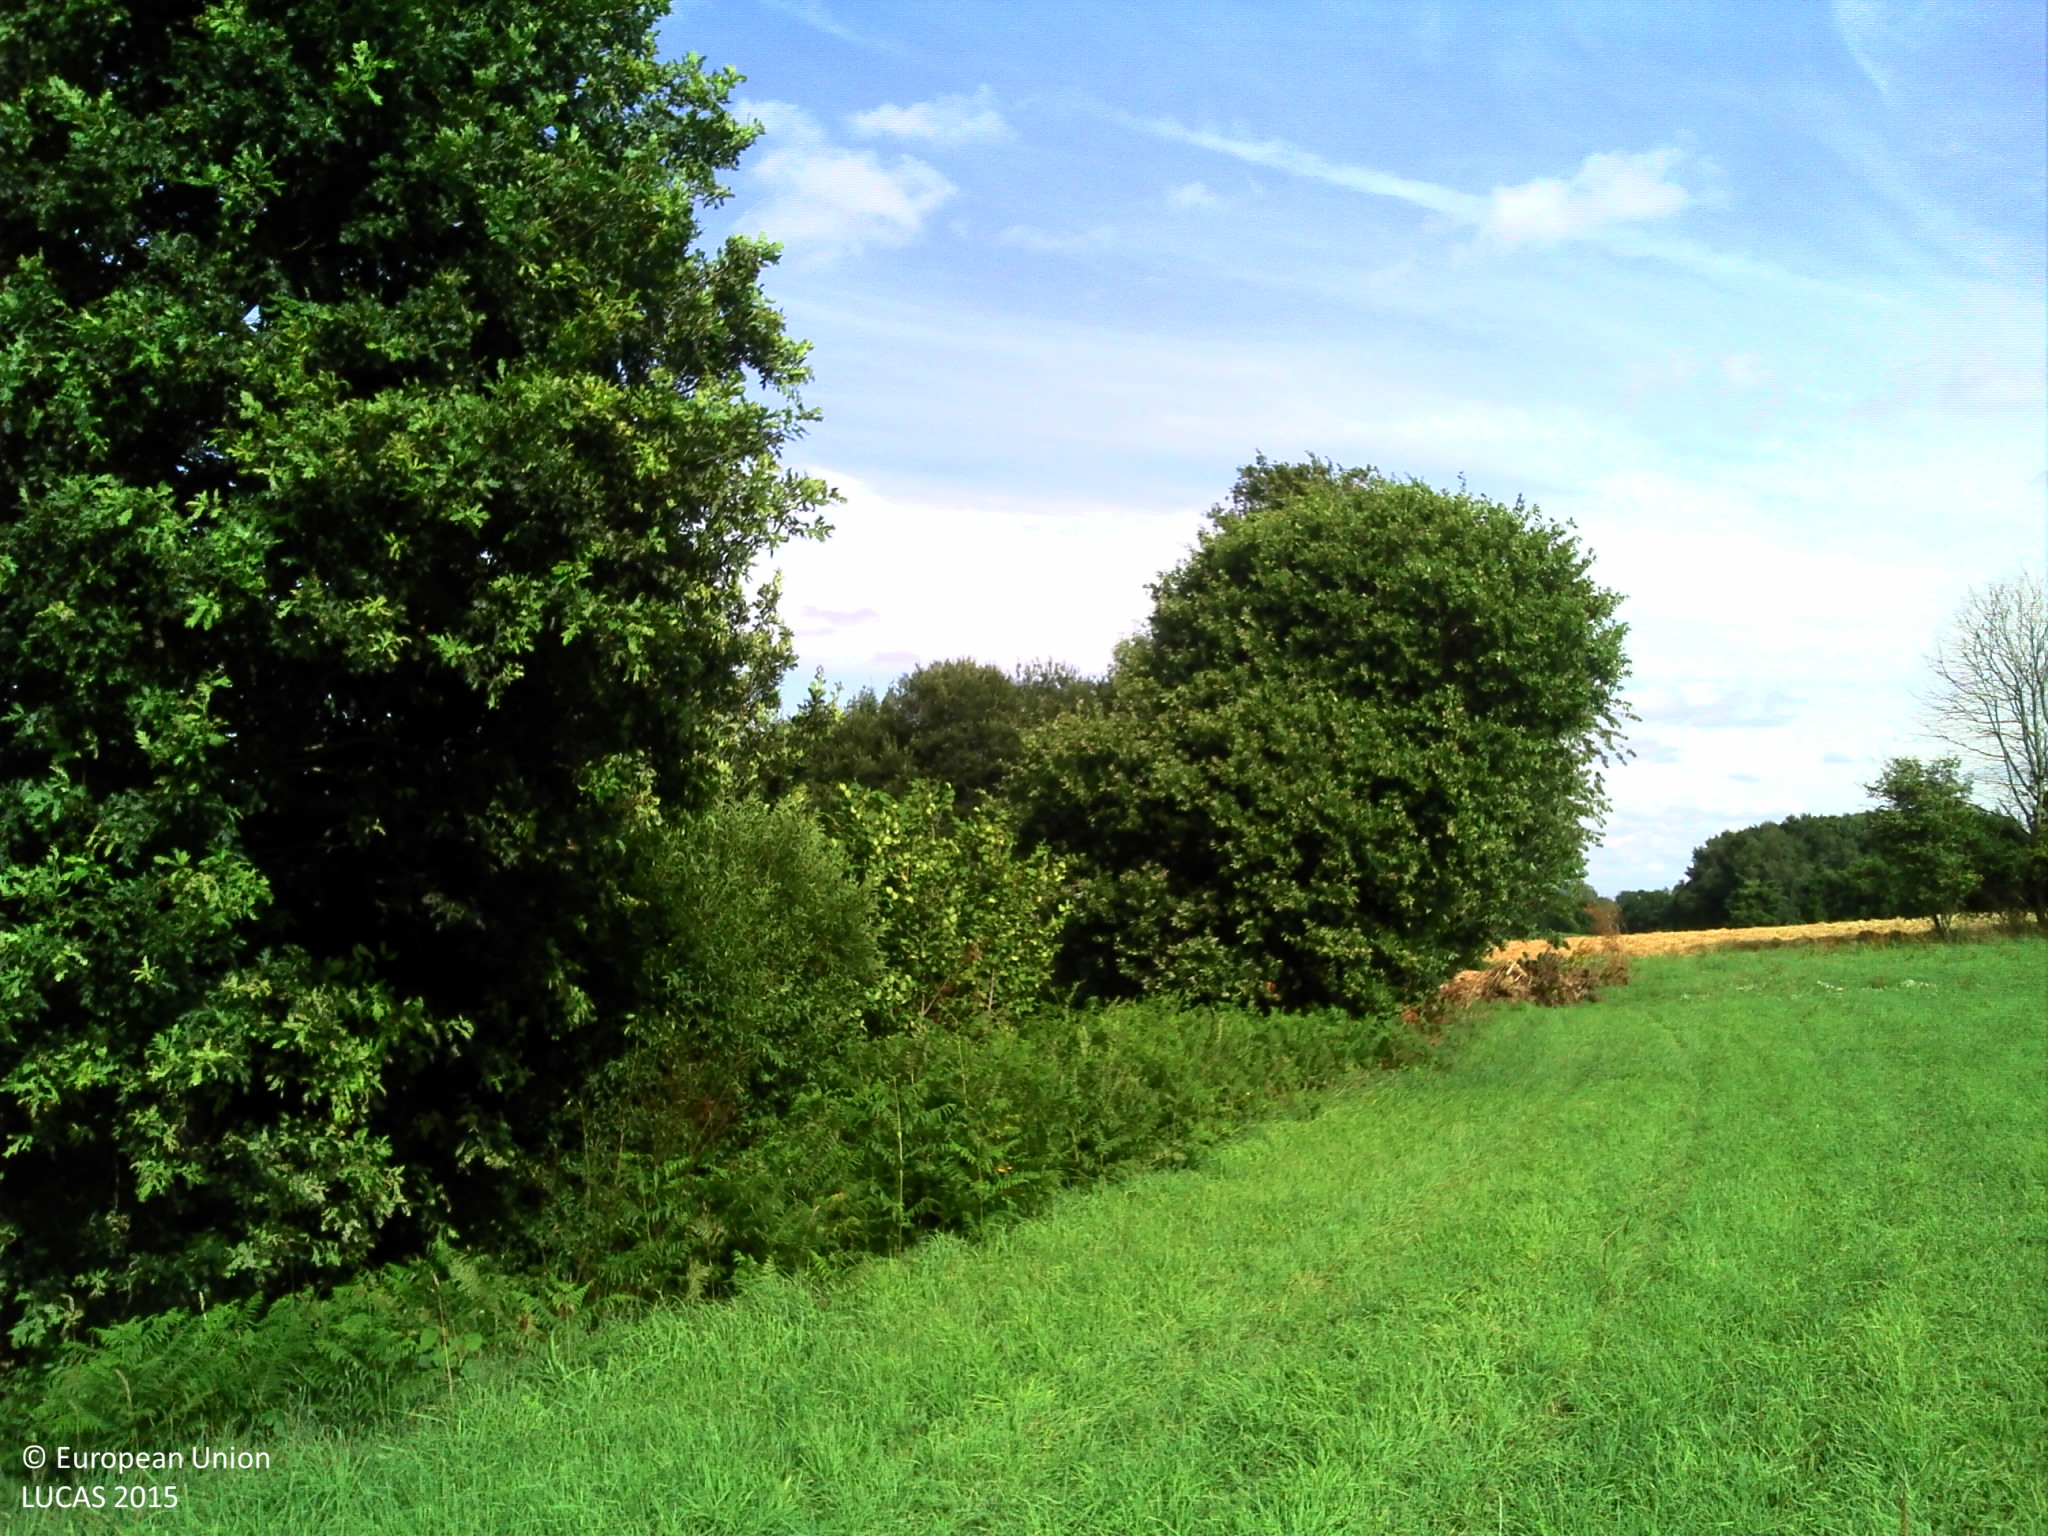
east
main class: Cropland
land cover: Temporary grasslands
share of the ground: > 75 %
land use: Agriculture (excluding fallow land and kitchen gardens)
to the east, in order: Temporary grasslands; Lines of trees; Fences; Grassland without tree/shrub cover; Fences; Ditches and canals; Lines of trees; Barley; Lines of trees; Fences; Grassland without tree/shrub cover
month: July
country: FR
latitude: 48.2621
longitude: -2.4395
